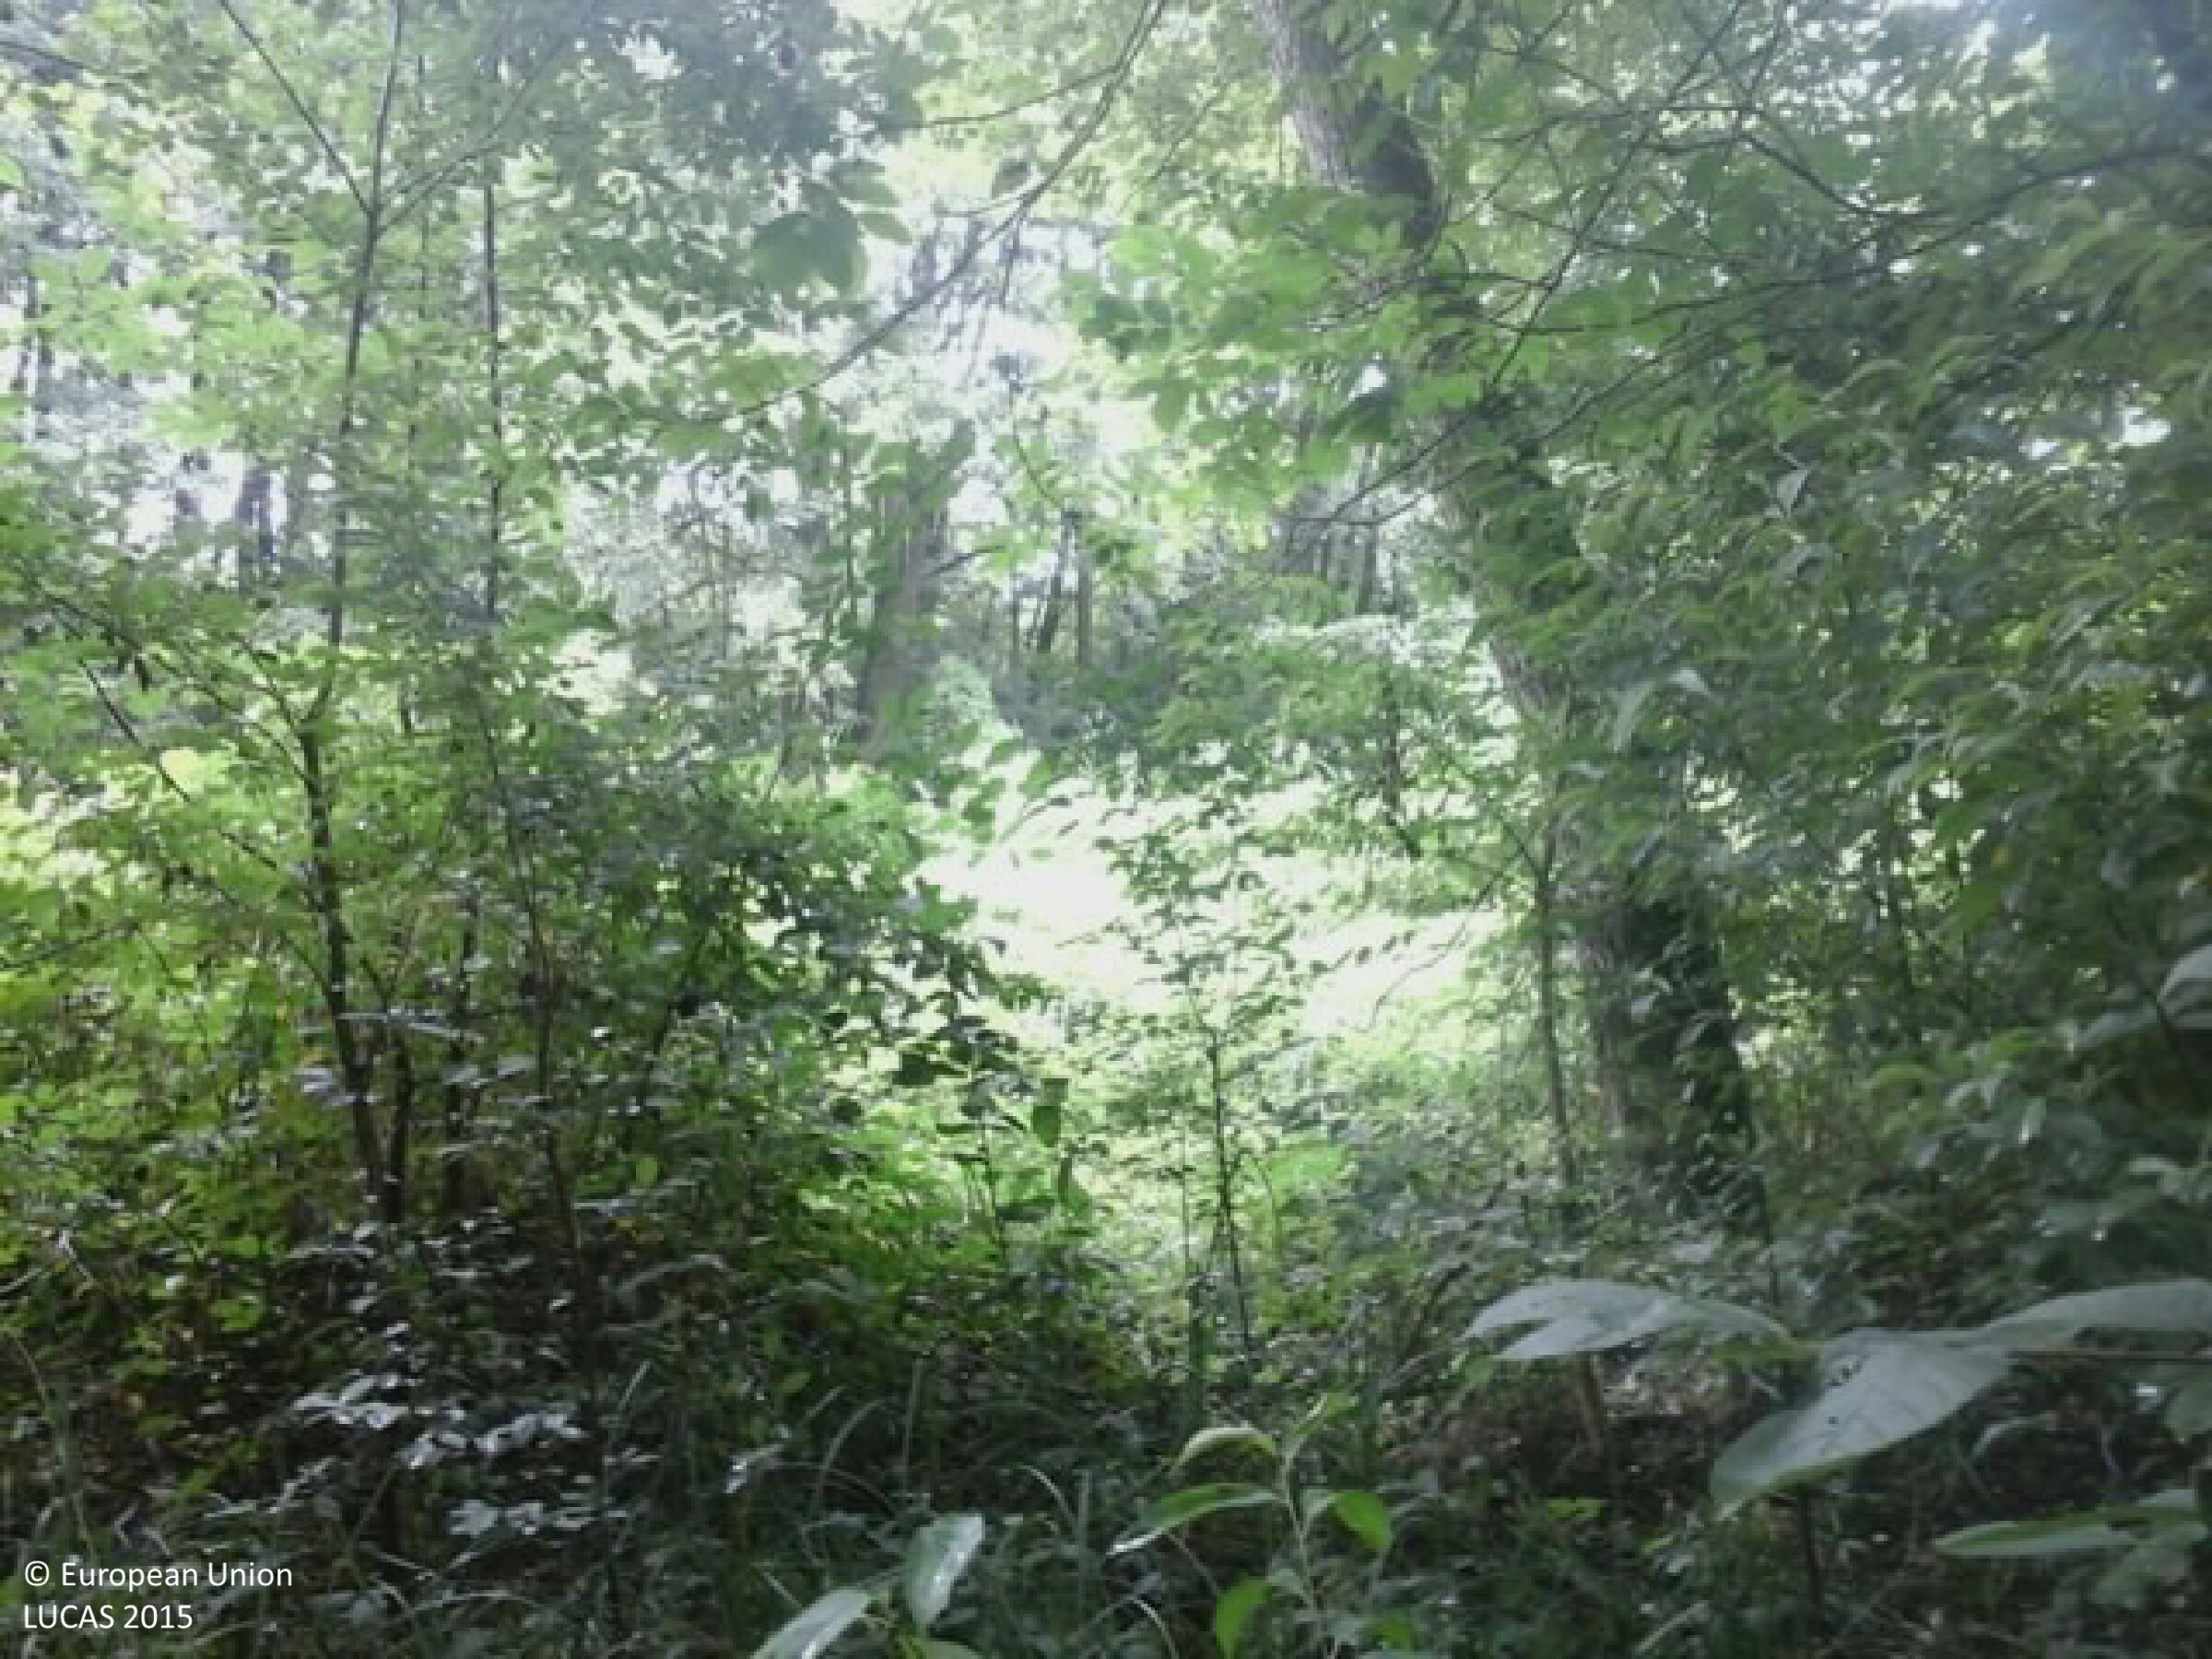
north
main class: Woodland
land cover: Broadleaved woodland
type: mesophytic deciduous forest
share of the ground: > 75 %
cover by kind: broadleaved forest trees 90 %, shrubs 5 %, herbaceous plants 5 %
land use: Semi-natural and natural areas not in use
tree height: > 5 m
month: July
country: HU
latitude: 46.3801
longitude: 17.1932
